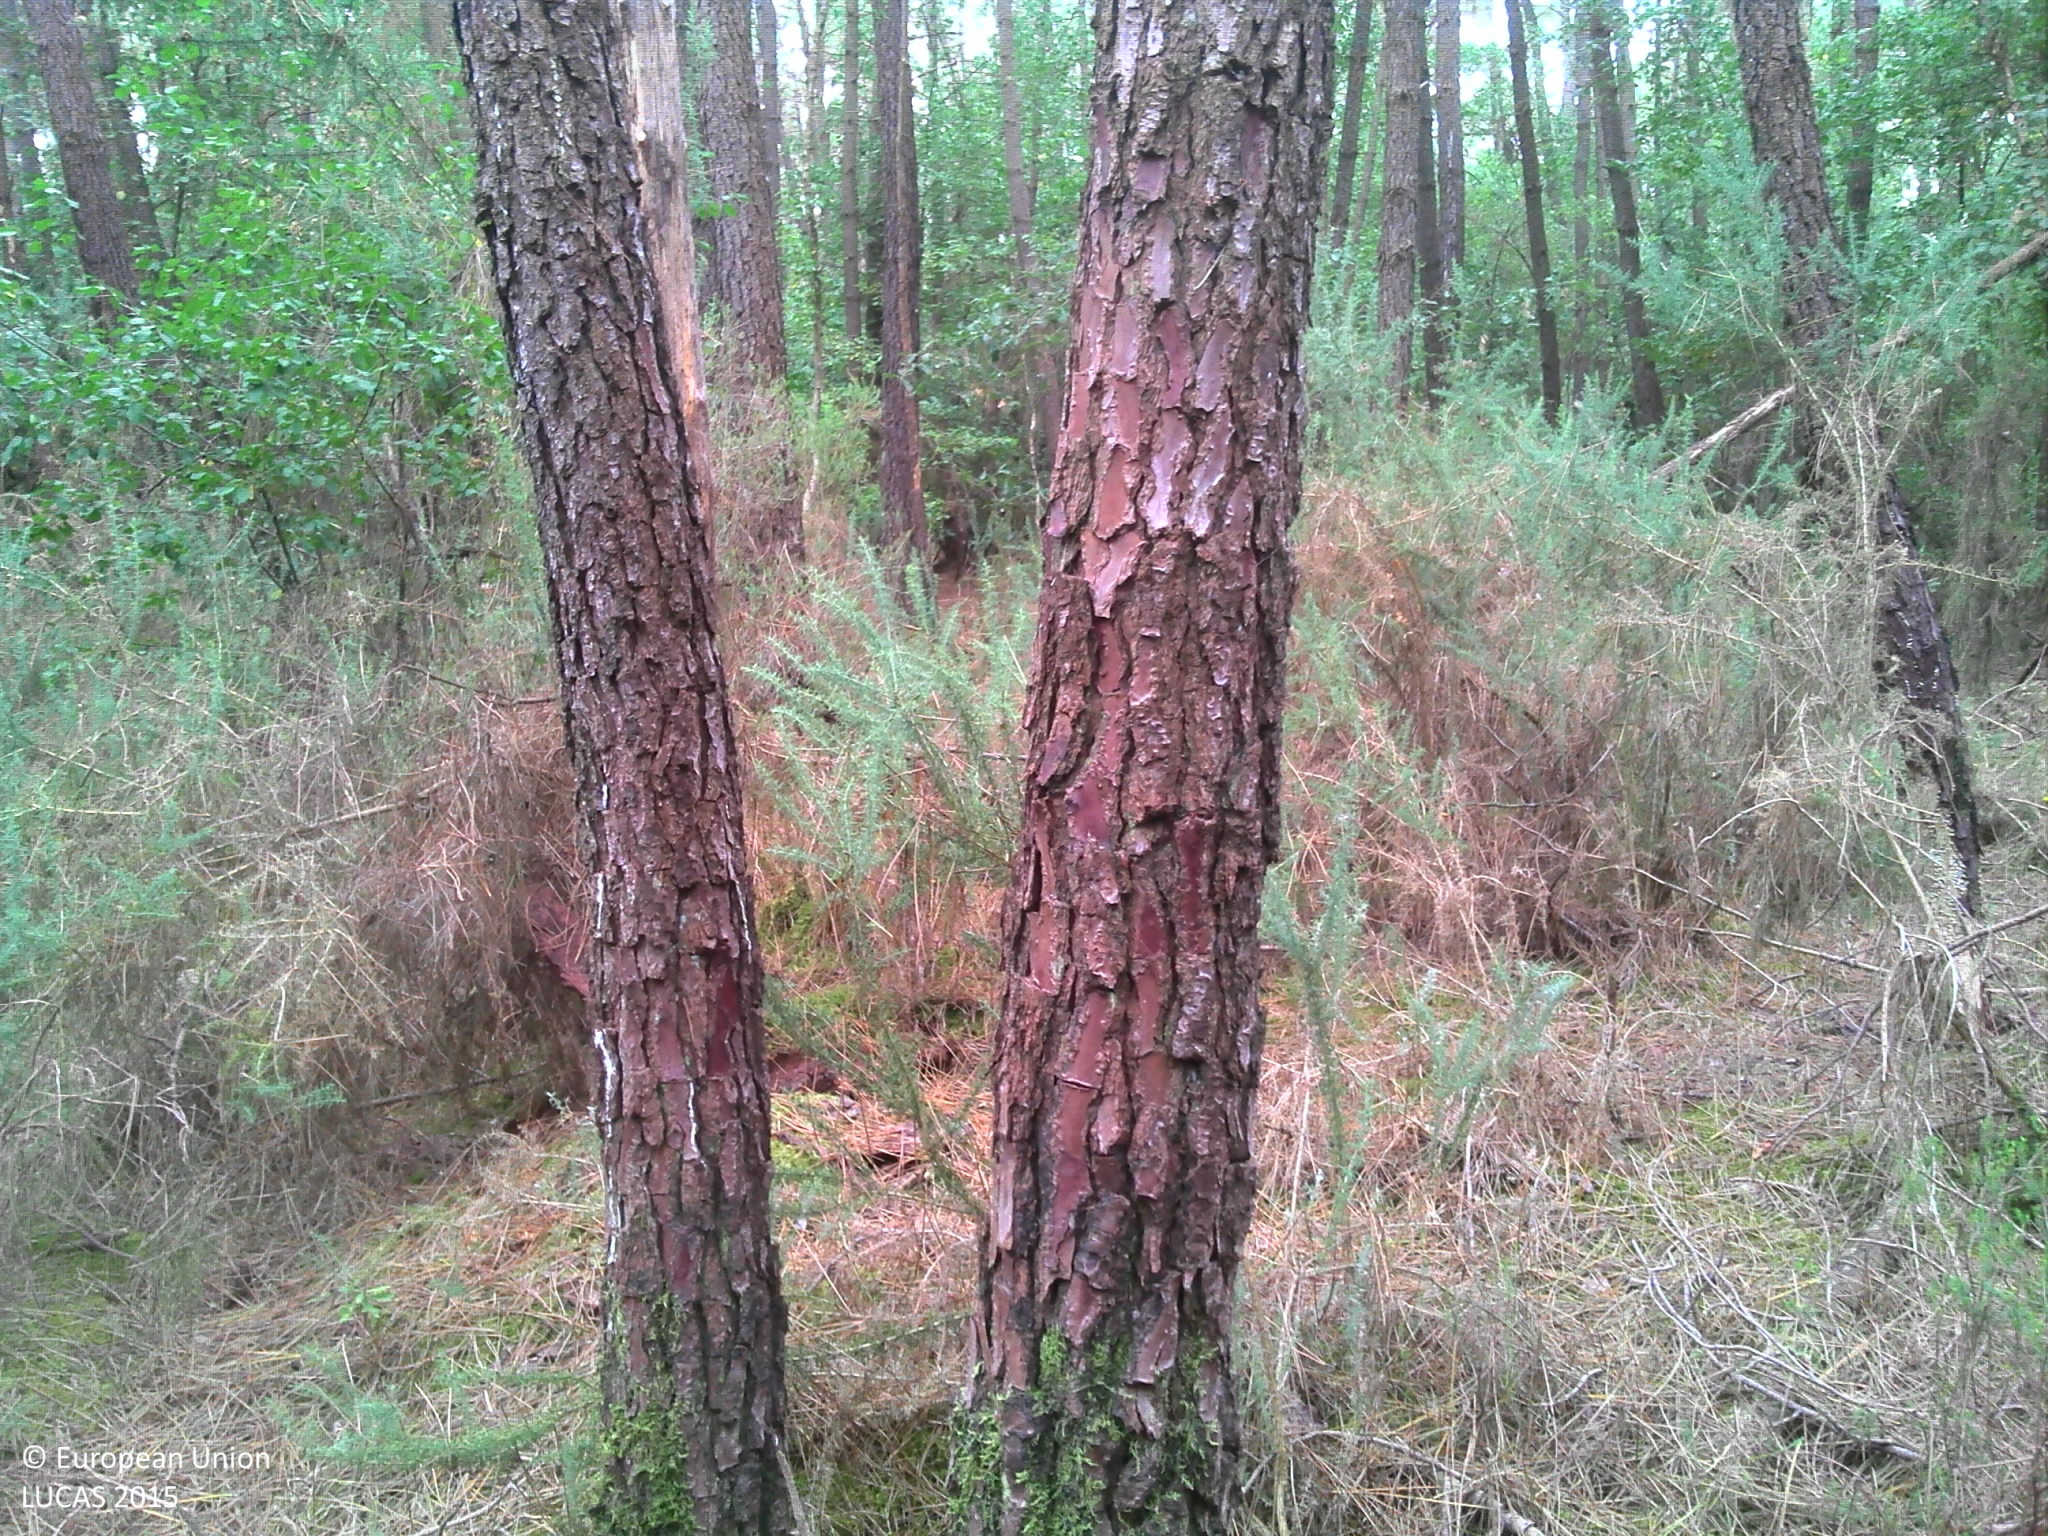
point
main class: Woodland
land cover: Pine dominated mixed woodland
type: hemiboreal forest and nemoral coniferous forest and mixed broadleaved-coniferous forest
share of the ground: > 75 %
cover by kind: coniferous forest trees 50 %, broadleaved forest trees 20 %, shrubs 15 %, herbaceous plants 10 %, lichens and mosses 5 %
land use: Forestry
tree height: > 5 m
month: July
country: FR
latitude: 46.9900
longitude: 0.4208
